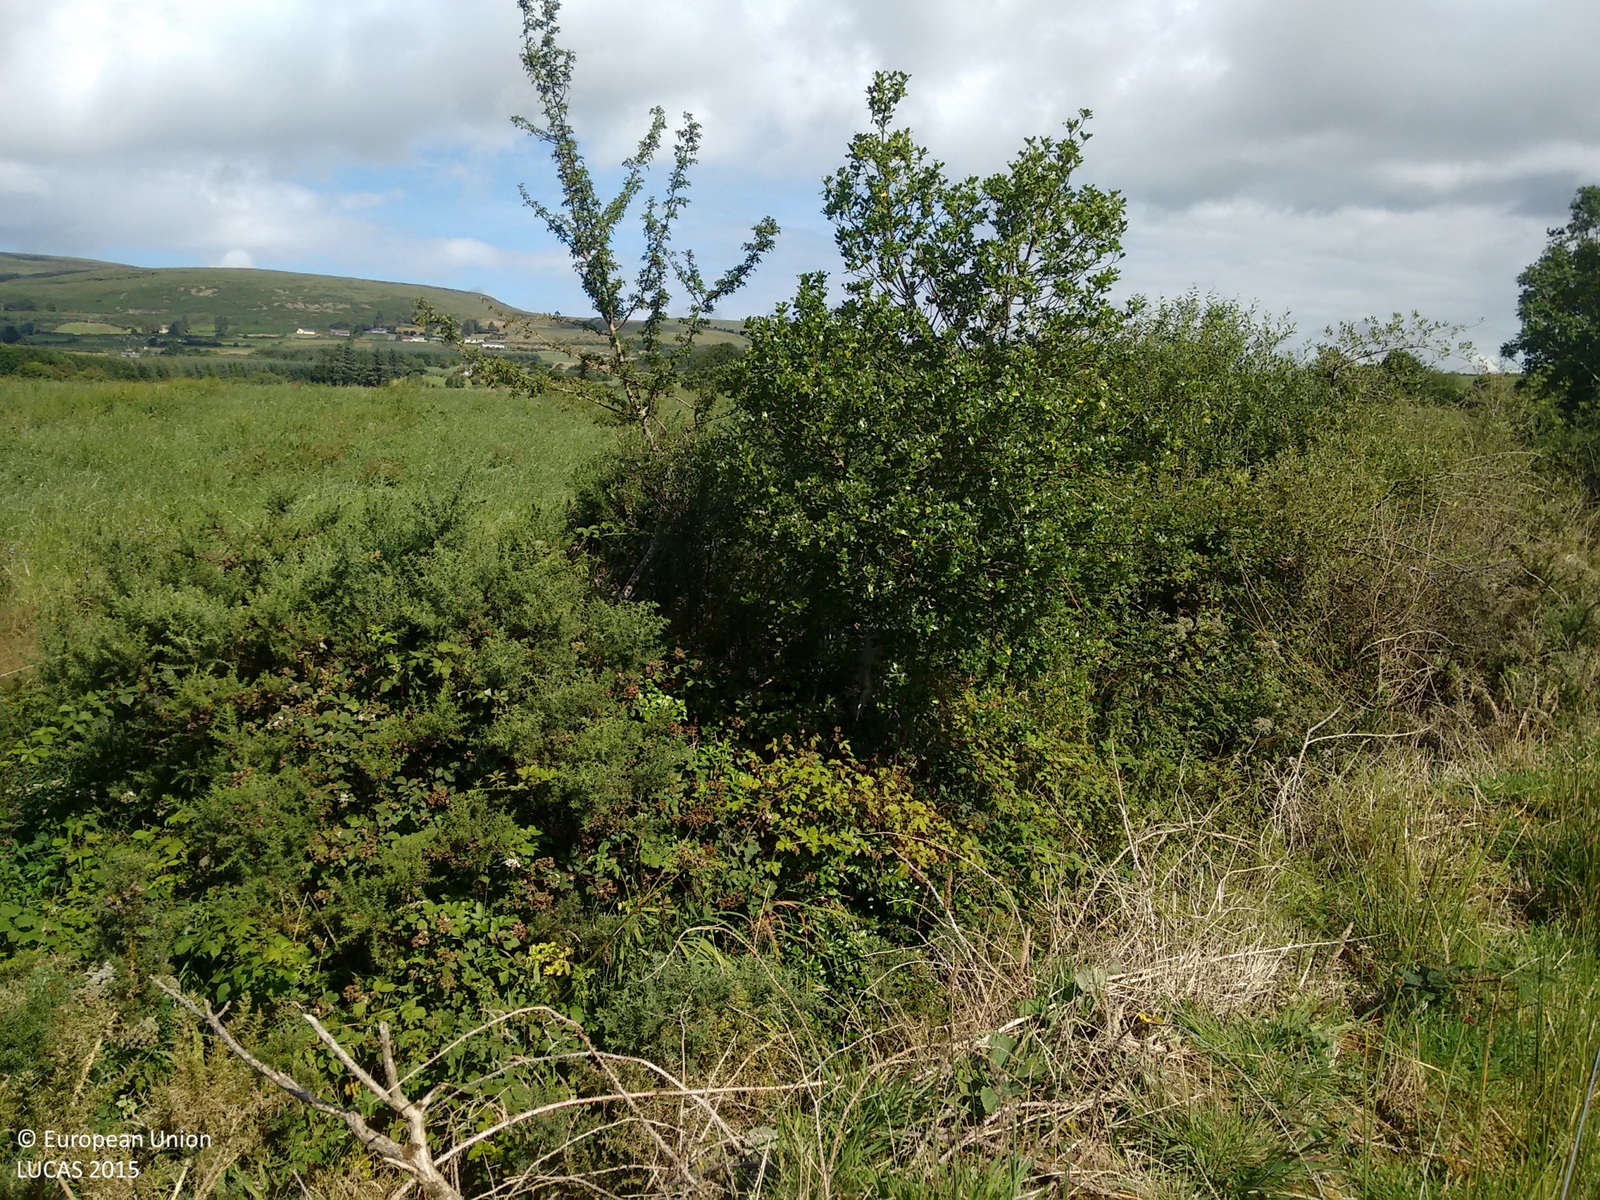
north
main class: Grassland
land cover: Grassland without tree/shrub cover
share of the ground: > 75 %
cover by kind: herbaceous plants 100 %
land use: Agriculture (excluding fallow land and kitchen gardens)
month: August
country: IE
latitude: 52.1932
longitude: -9.6521
